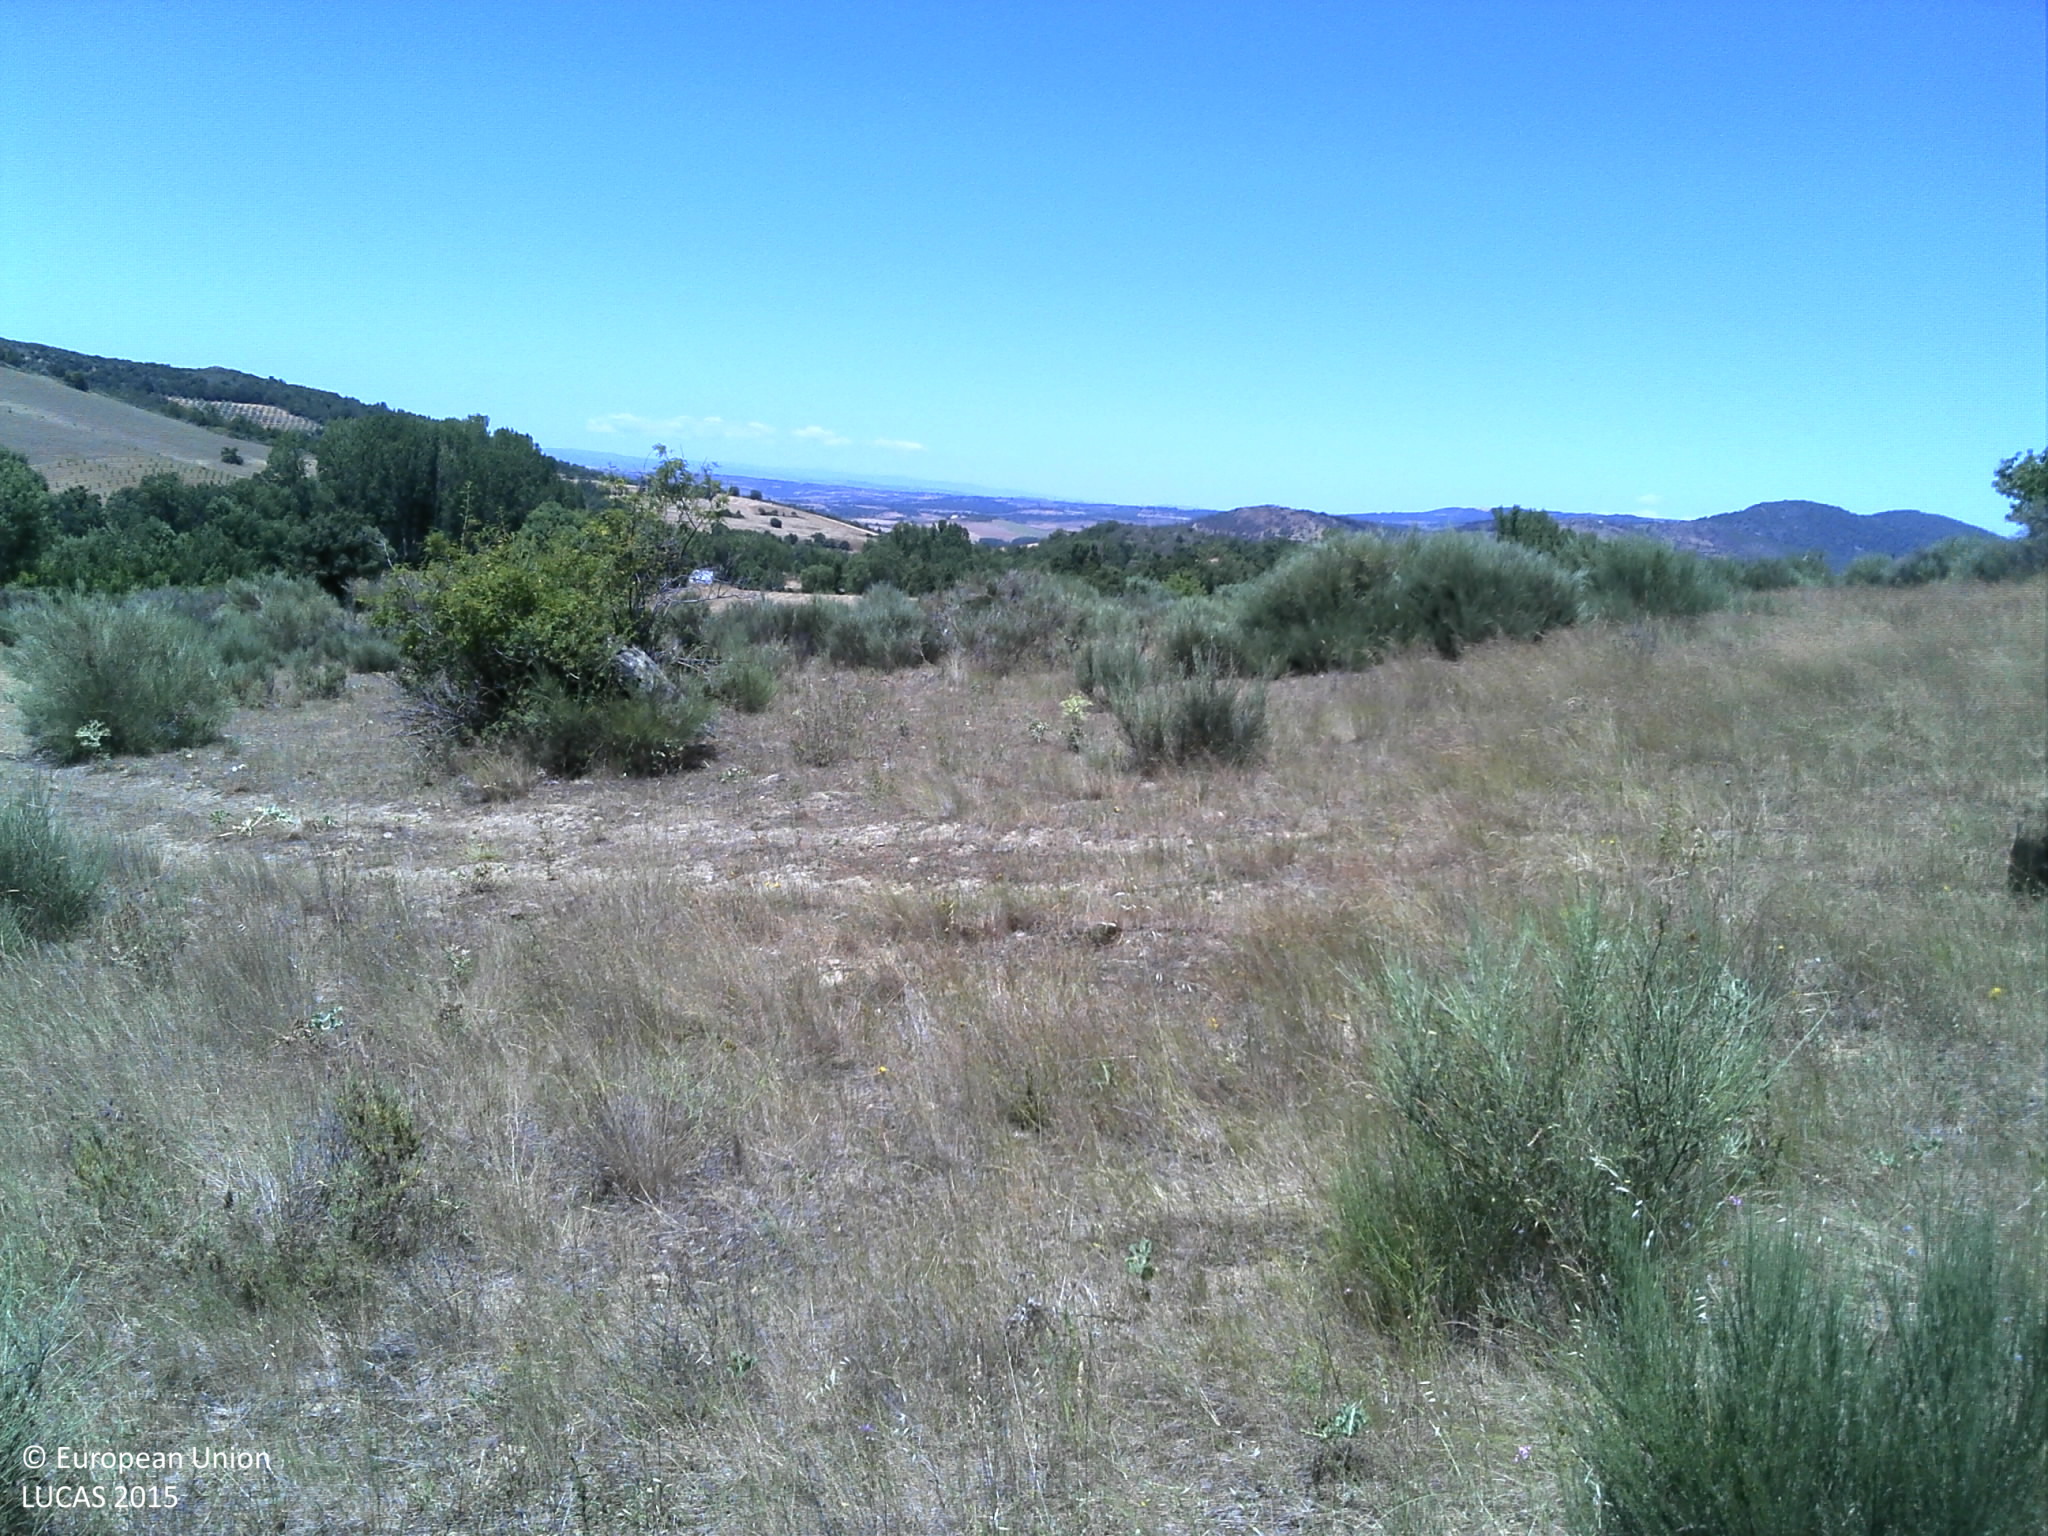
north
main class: Grassland
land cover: Grassland without tree/shrub cover
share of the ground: > 75 %
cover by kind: herbaceous plants 100 %
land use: Agriculture (excluding fallow land and kitchen gardens)
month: June
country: PT
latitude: 41.4787
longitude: -7.0120
